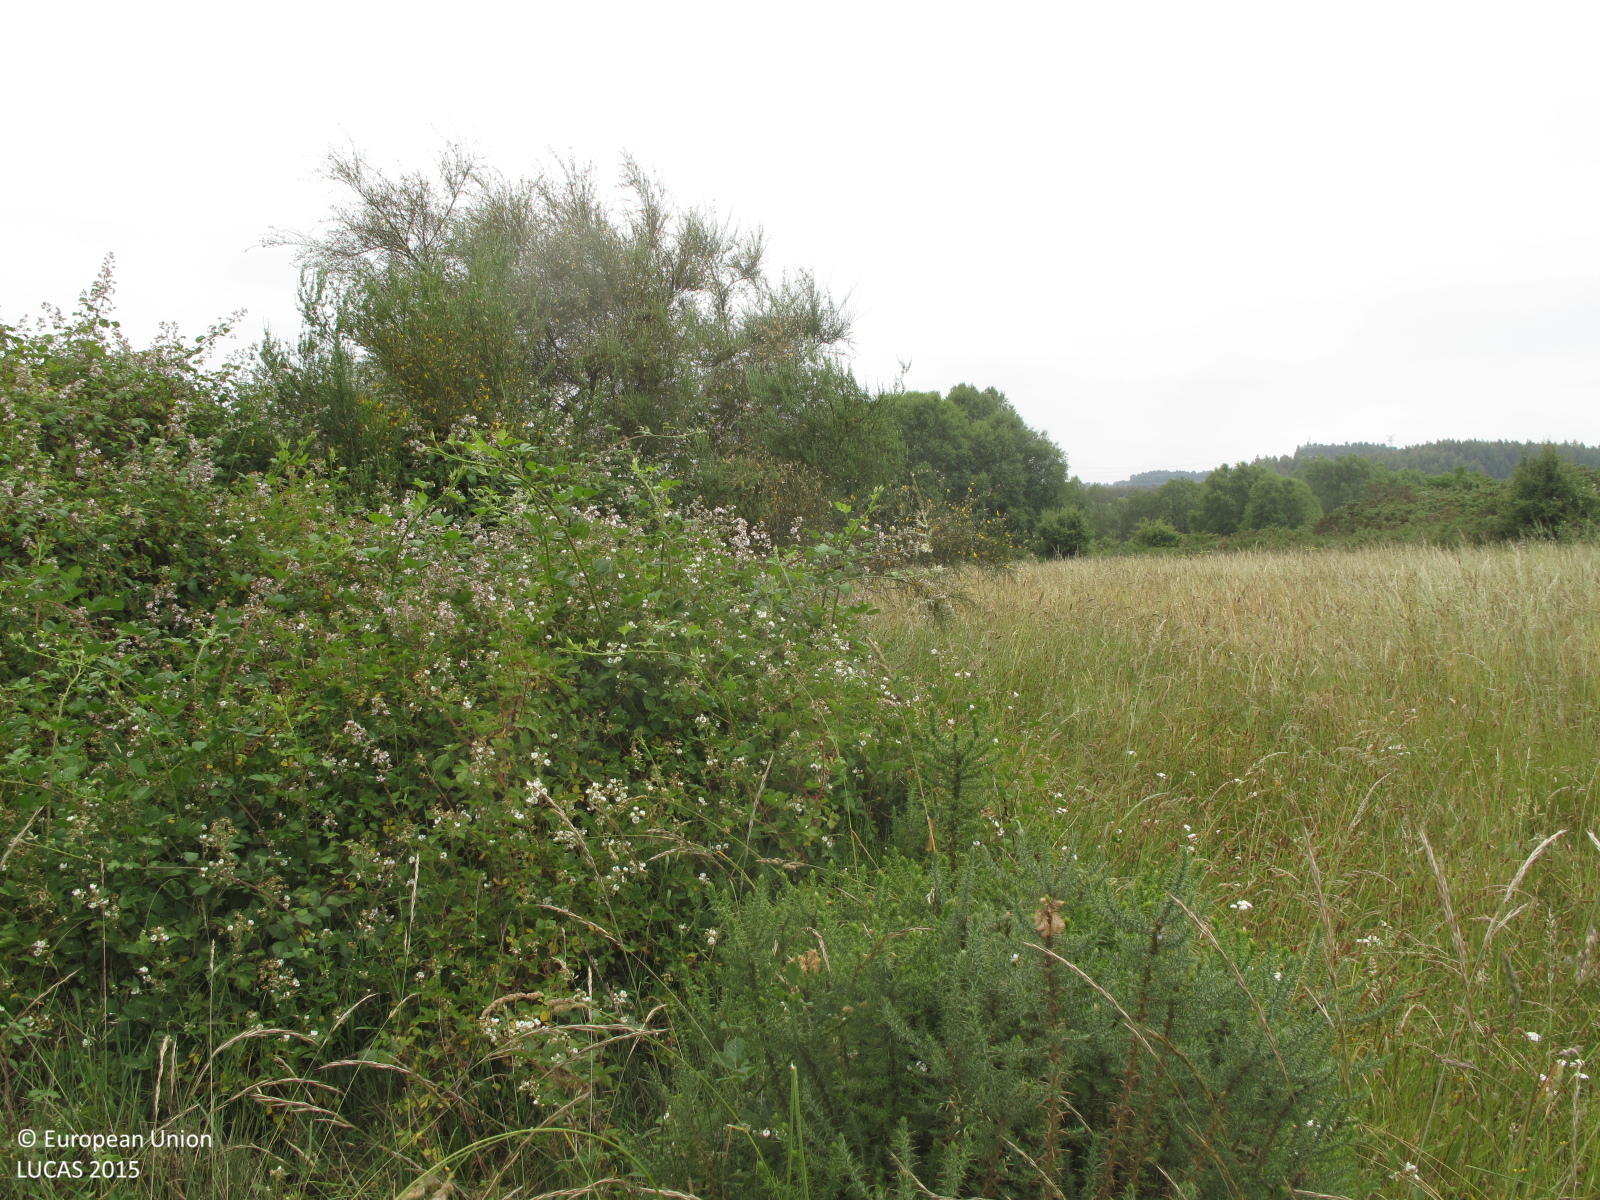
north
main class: Shrubland
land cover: Shrubland with sparse tree cover
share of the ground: > 75 %
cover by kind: shrubs 85 %, herbaceous plants 10 %, broadleaved forest trees 5 %
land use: Abandoned areas
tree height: < 5 m
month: June
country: ES
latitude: 43.1511
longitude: -8.0846
